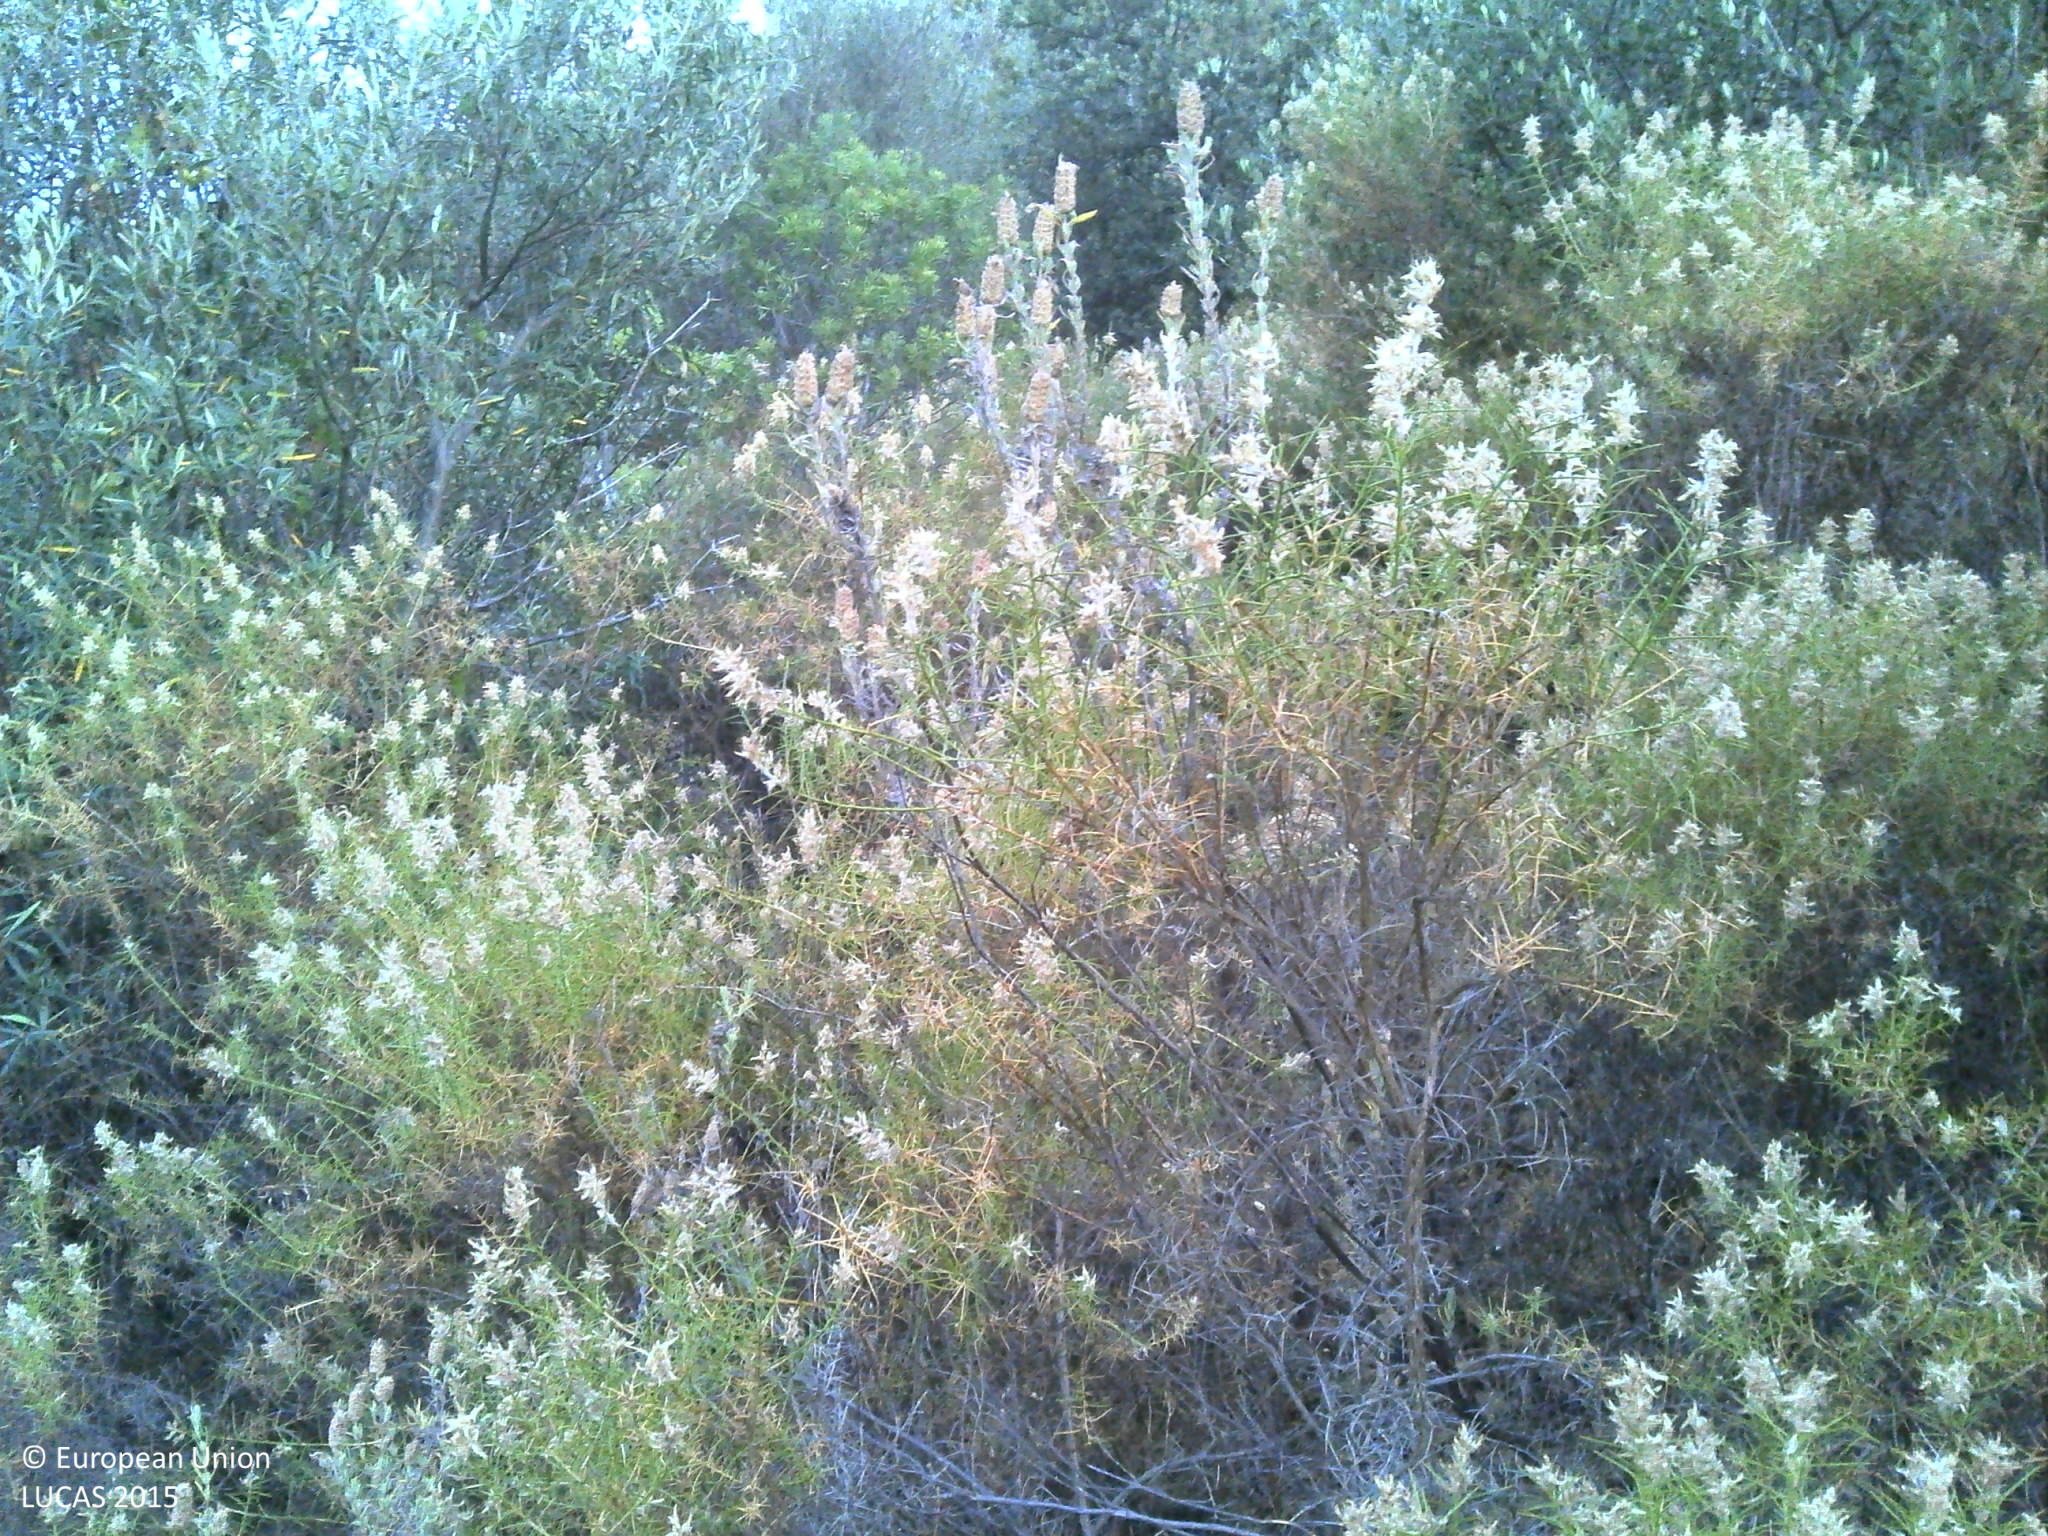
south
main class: Shrubland
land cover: Shrubland with sparse tree cover
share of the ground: > 75 %
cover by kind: shrubs 95 %, broadleaved forest trees 5 %
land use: Abandoned areas
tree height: < 5 m
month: June
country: PT
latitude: 37.1691
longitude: -7.6763
